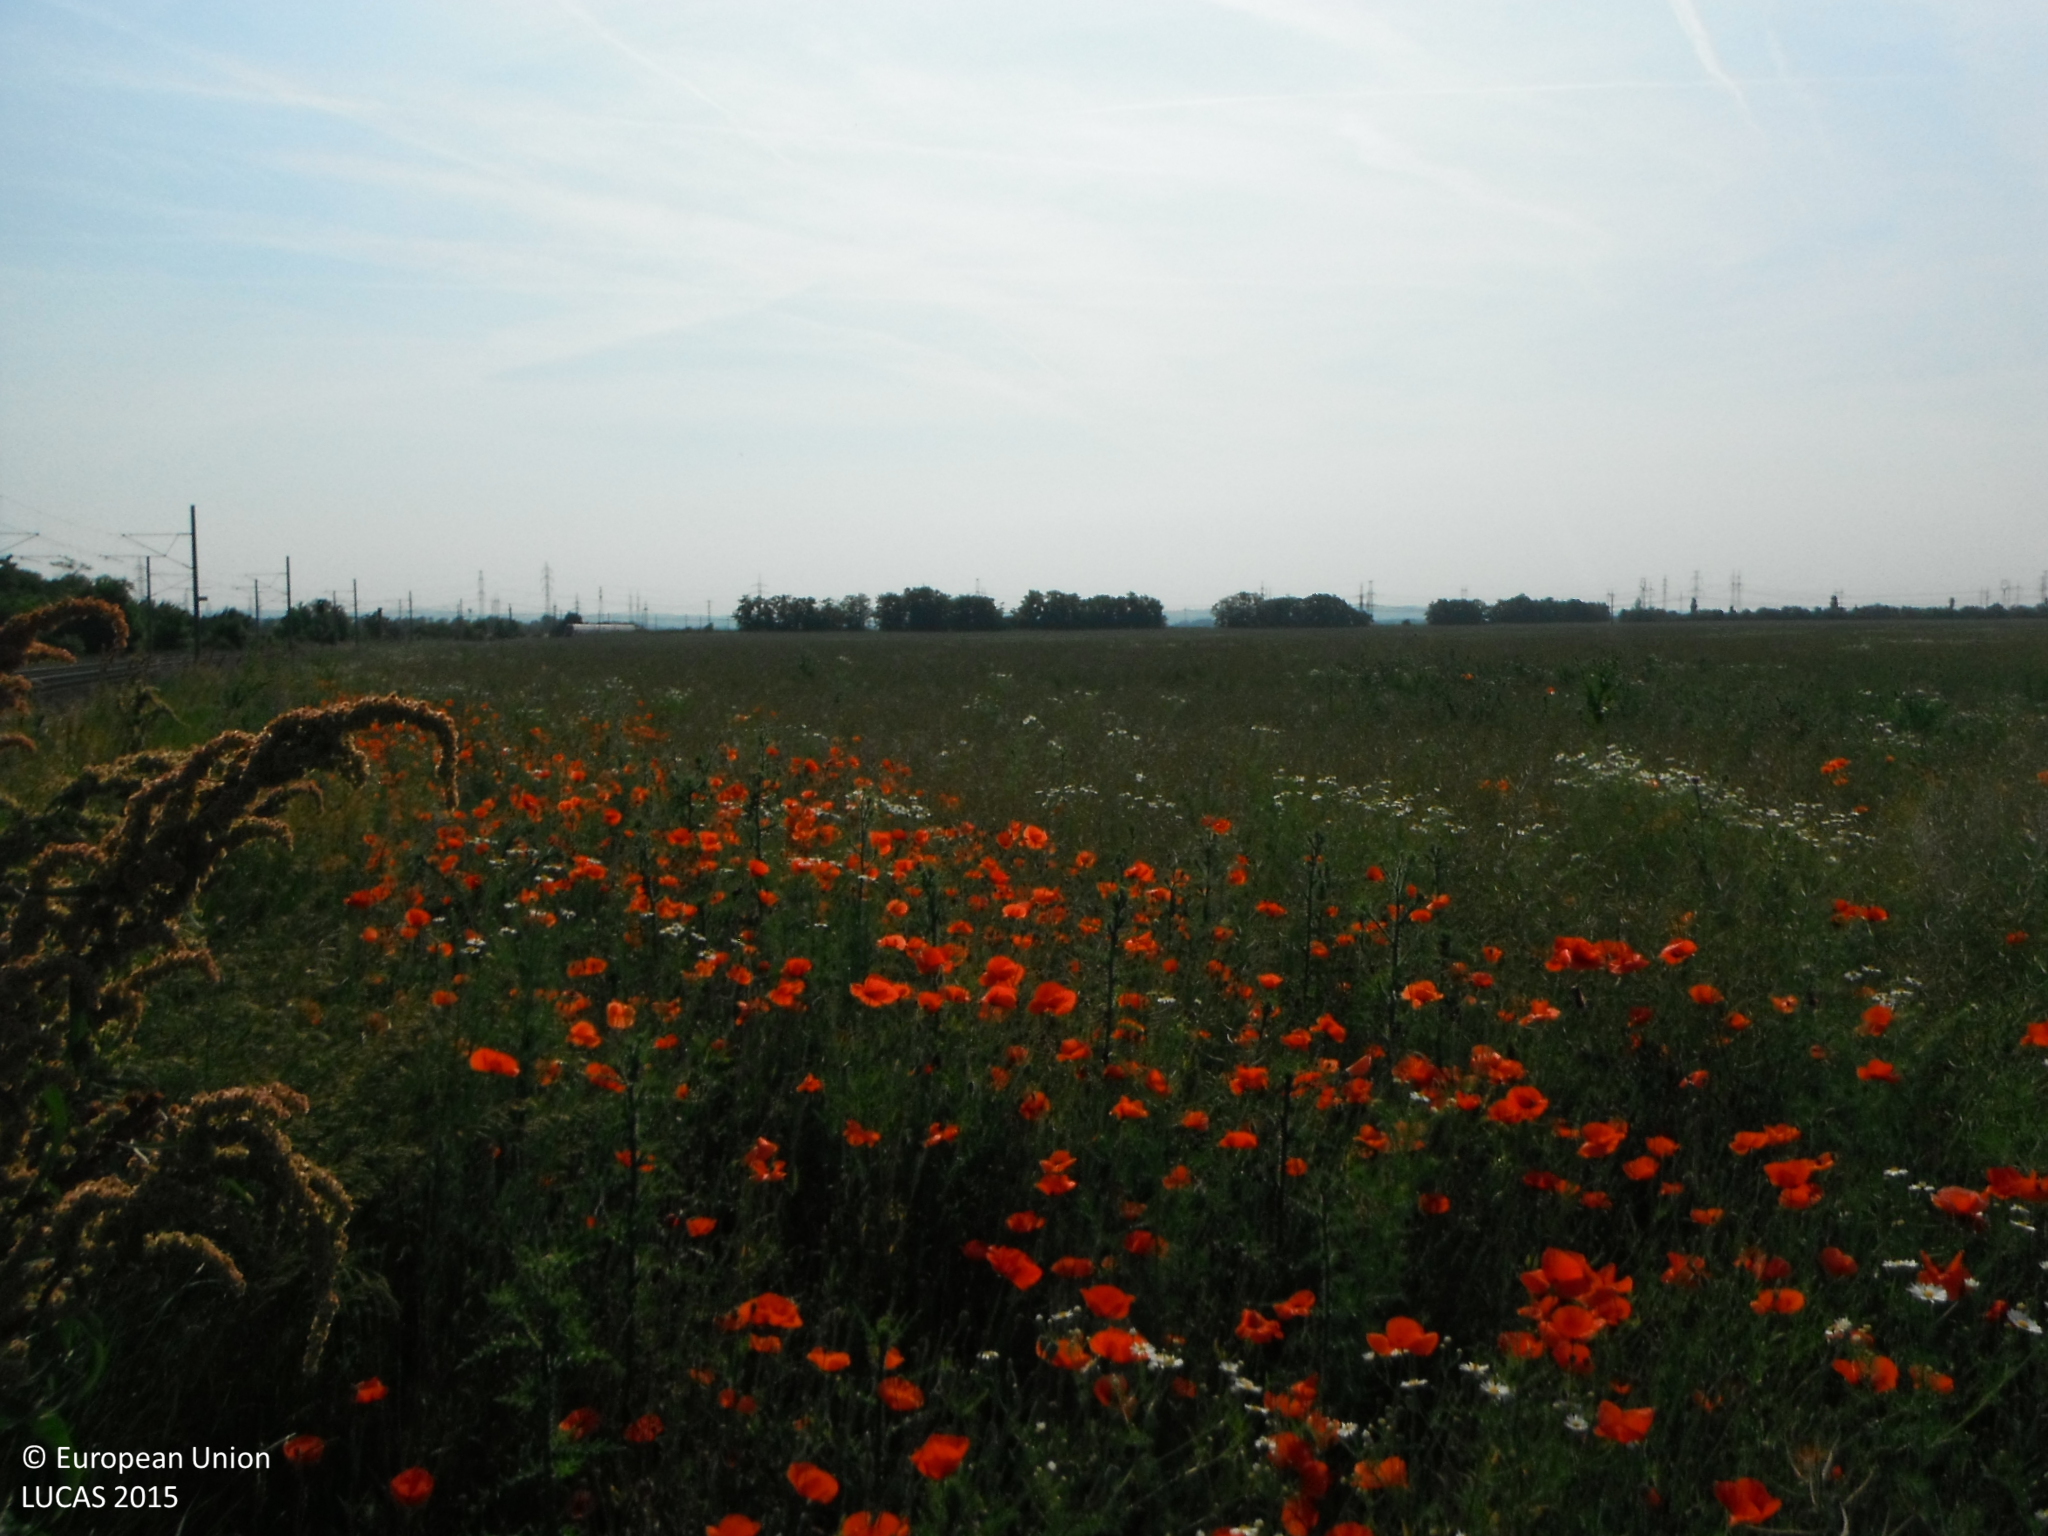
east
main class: Cropland
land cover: Rape and turnip rape
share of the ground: > 75 %
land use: Agriculture (excluding fallow land and kitchen gardens)
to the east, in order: Rape and turnip rape
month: June
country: SK
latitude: 48.3740
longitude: 17.6388
